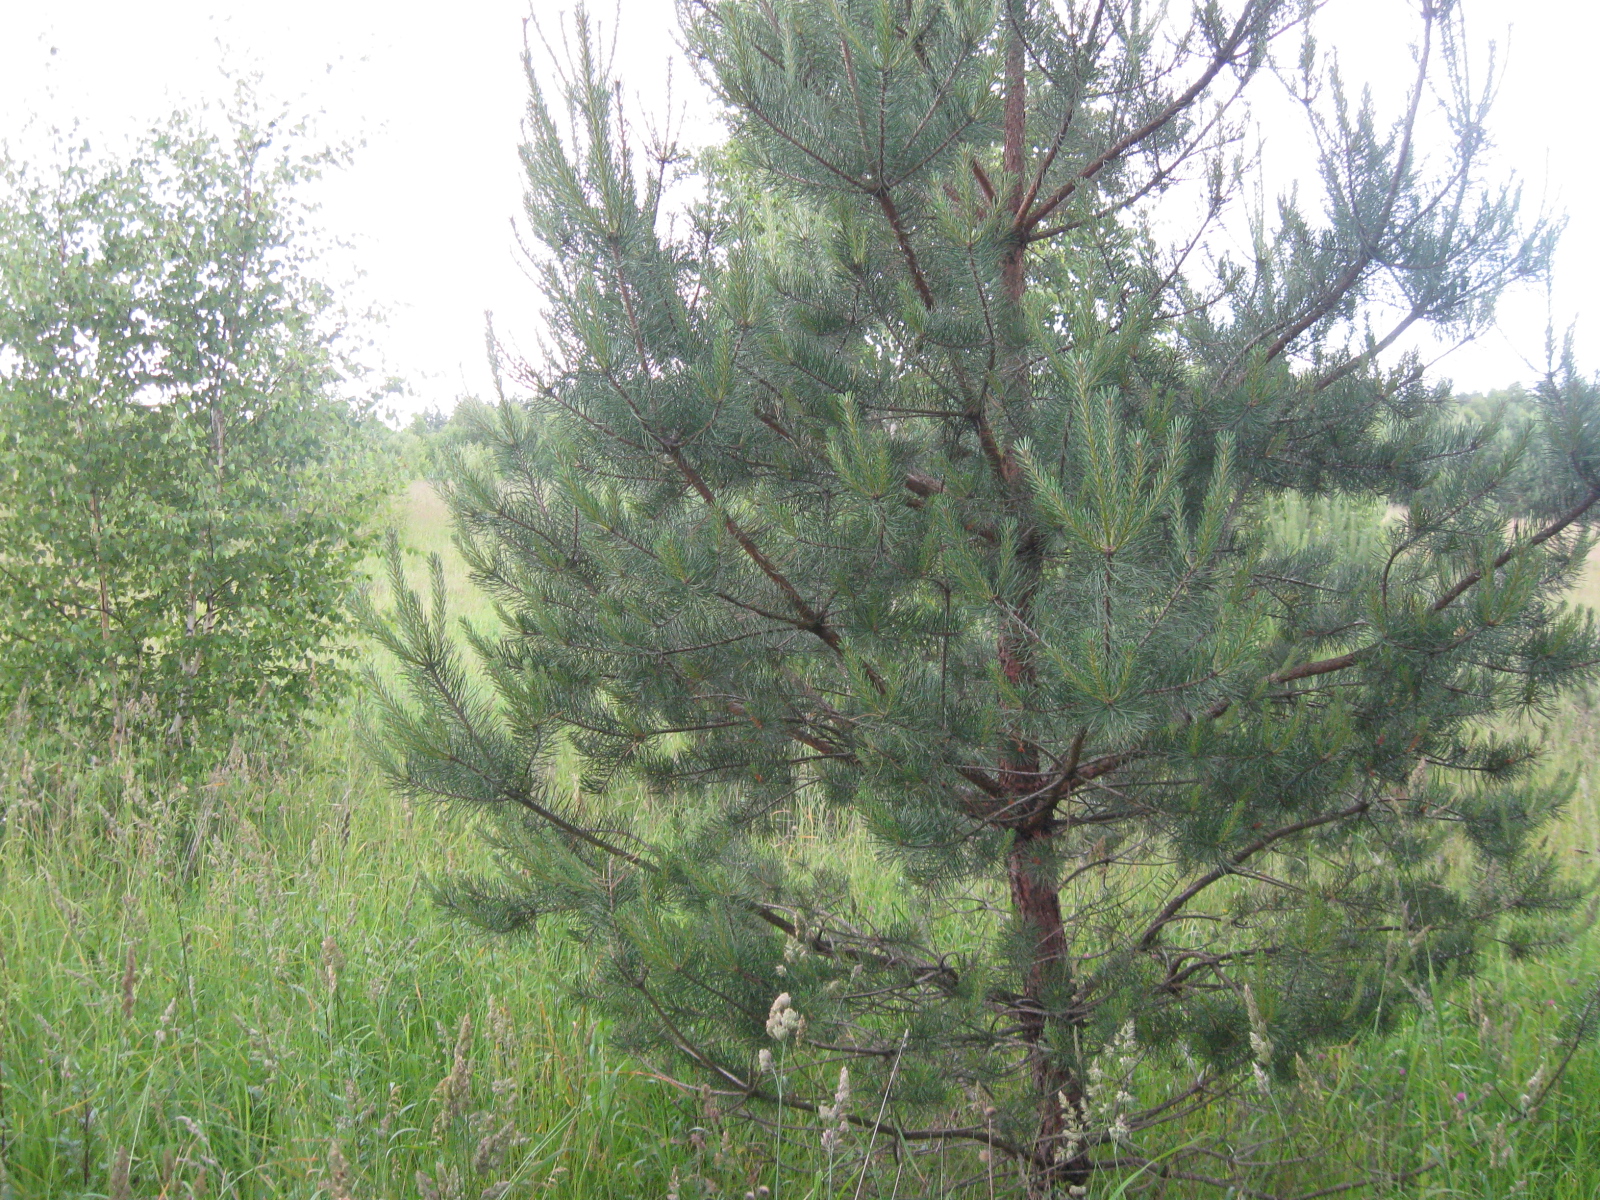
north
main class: Woodland
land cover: Pine dominated mixed woodland
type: hemiboreal forest and nemoral coniferous forest and mixed broadleaved-coniferous forest
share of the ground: 25 - 50 %
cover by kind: herbaceous plants 65 %, coniferous forest trees 20 %, broadleaved forest trees 15 %
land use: Forestry
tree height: < 5 m
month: June
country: LT
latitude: 54.5778
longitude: 24.4430
